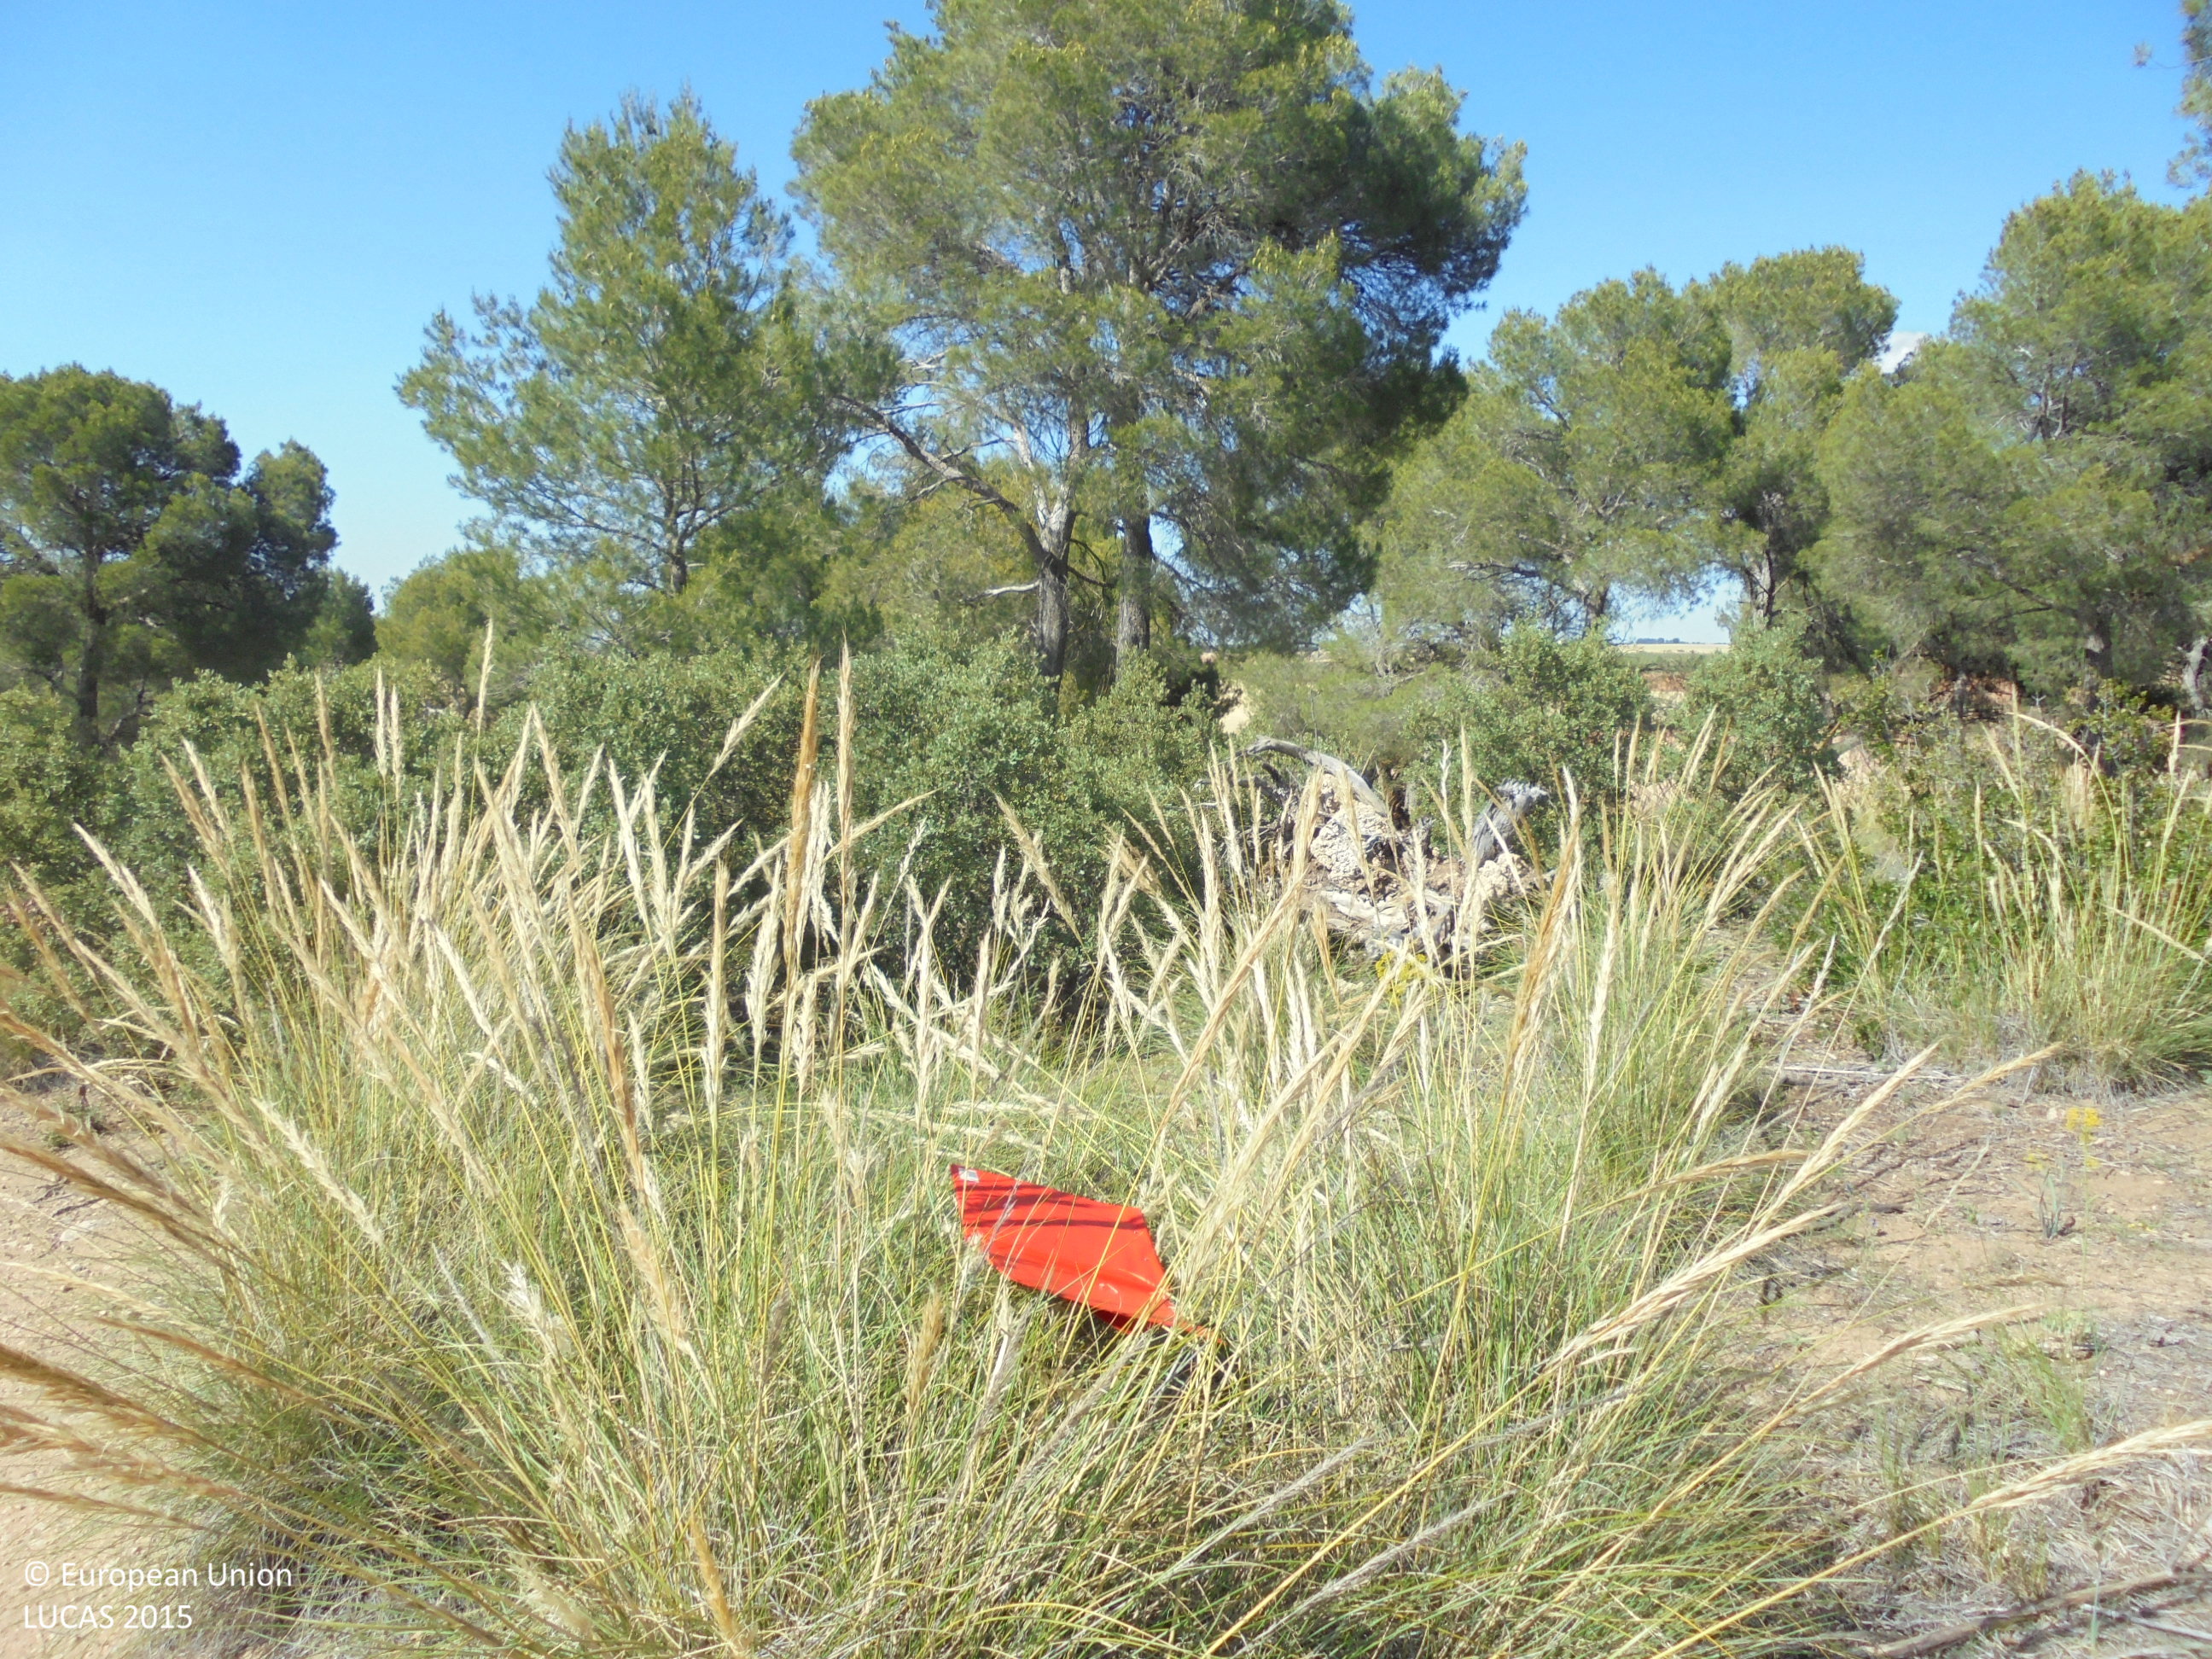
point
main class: Woodland
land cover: Pine dominated coniferous woodland
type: coniferous forest of the mediterranean region
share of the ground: 50 - 75 %
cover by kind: coniferous forest trees 60 %, shrubs 30 %, unconsolidated bare surface 10 %
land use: Semi-natural and natural areas not in use
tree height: > 5 m
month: June
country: ES
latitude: 38.7635
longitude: -1.6774
